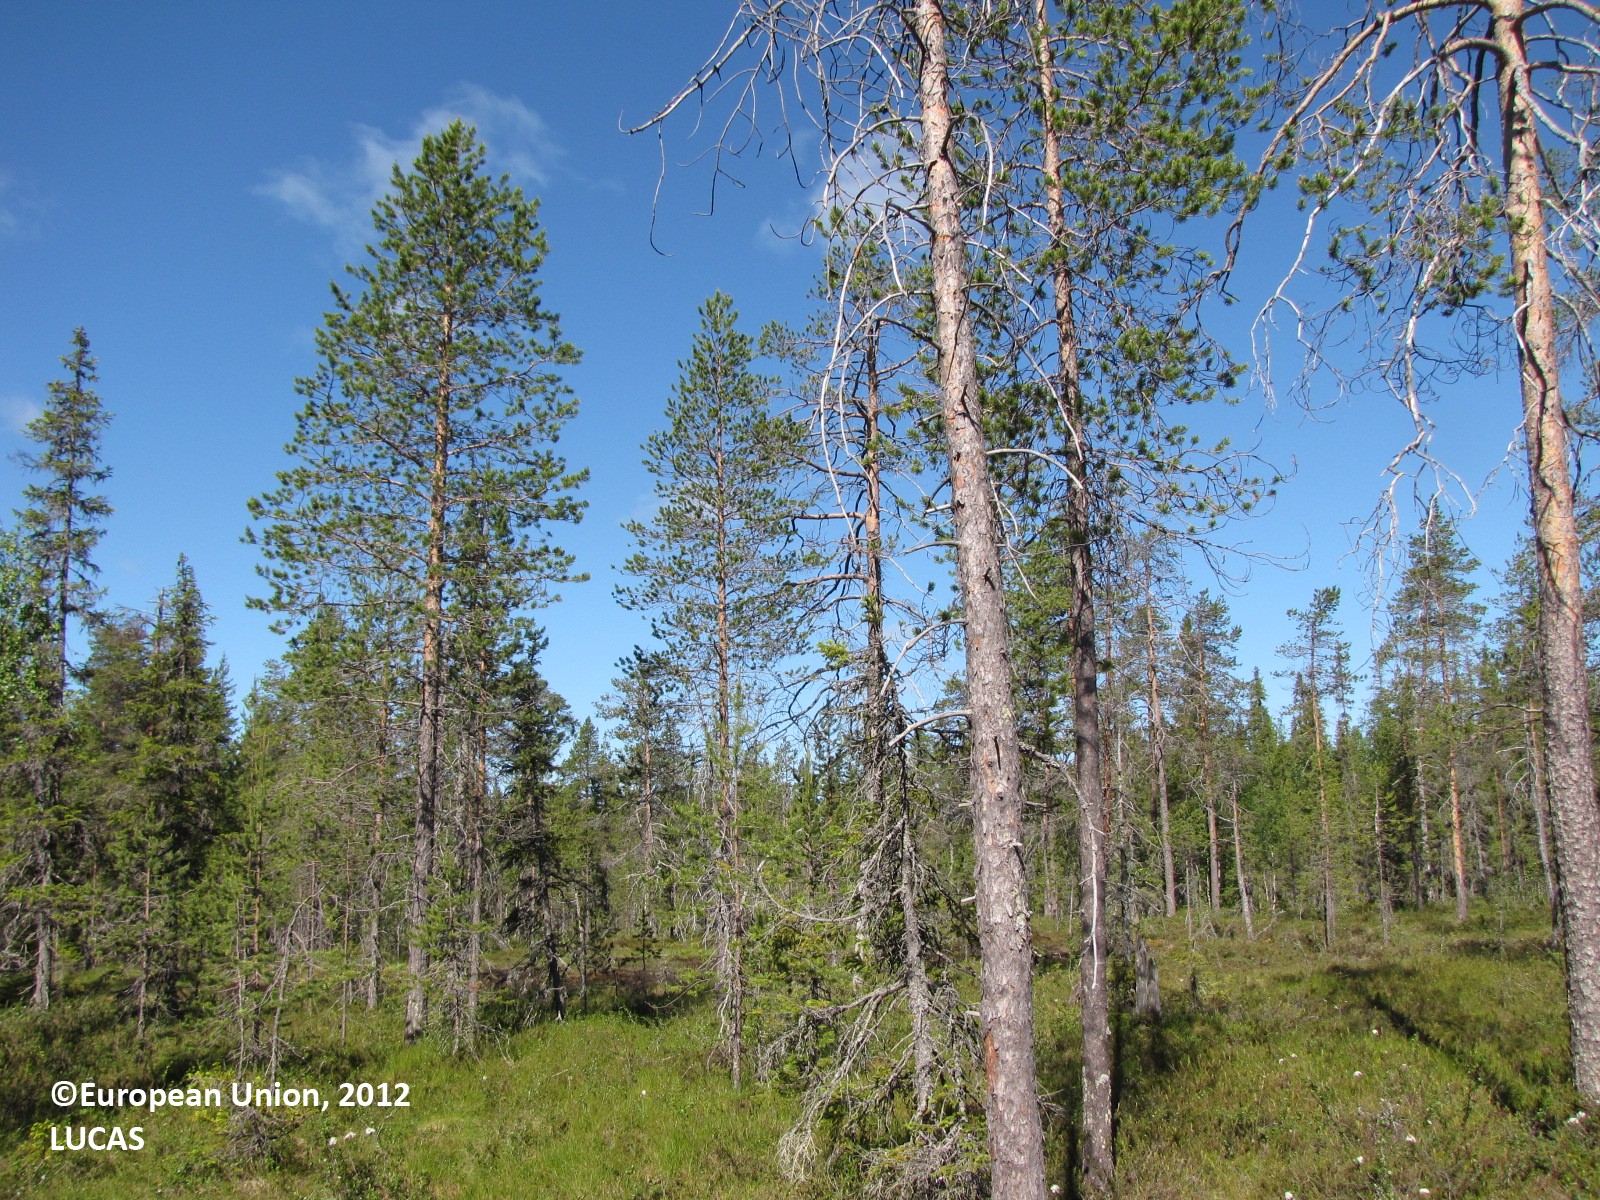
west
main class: Woodland
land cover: Pine dominated coniferous woodland
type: boreal forest
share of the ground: 25 - 50 %
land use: Forestry
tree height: > 5 m
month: July
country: FI
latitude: 66.4659
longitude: 24.8414
